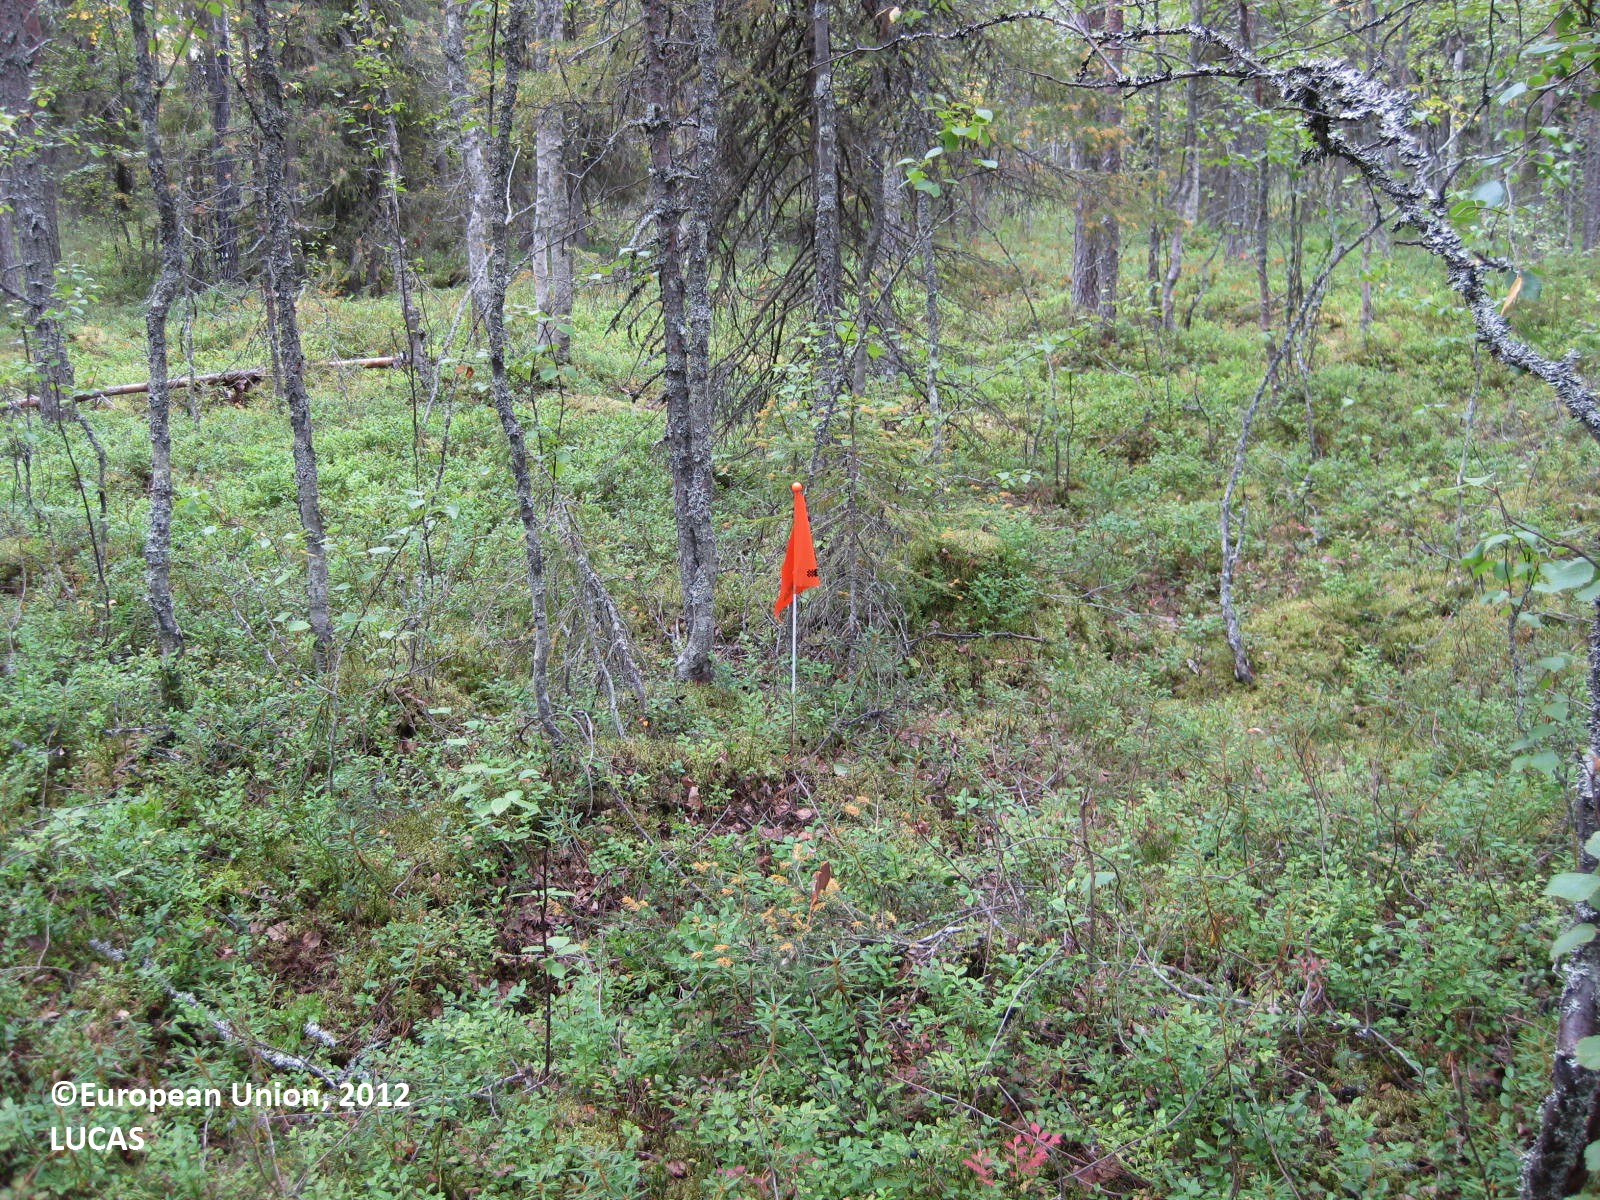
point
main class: Woodland
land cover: Pine dominated mixed woodland
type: boreal forest
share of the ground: 50 - 75 %
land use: Forestry
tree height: > 5 m
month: August
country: FI
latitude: 66.2839
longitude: 28.8556
